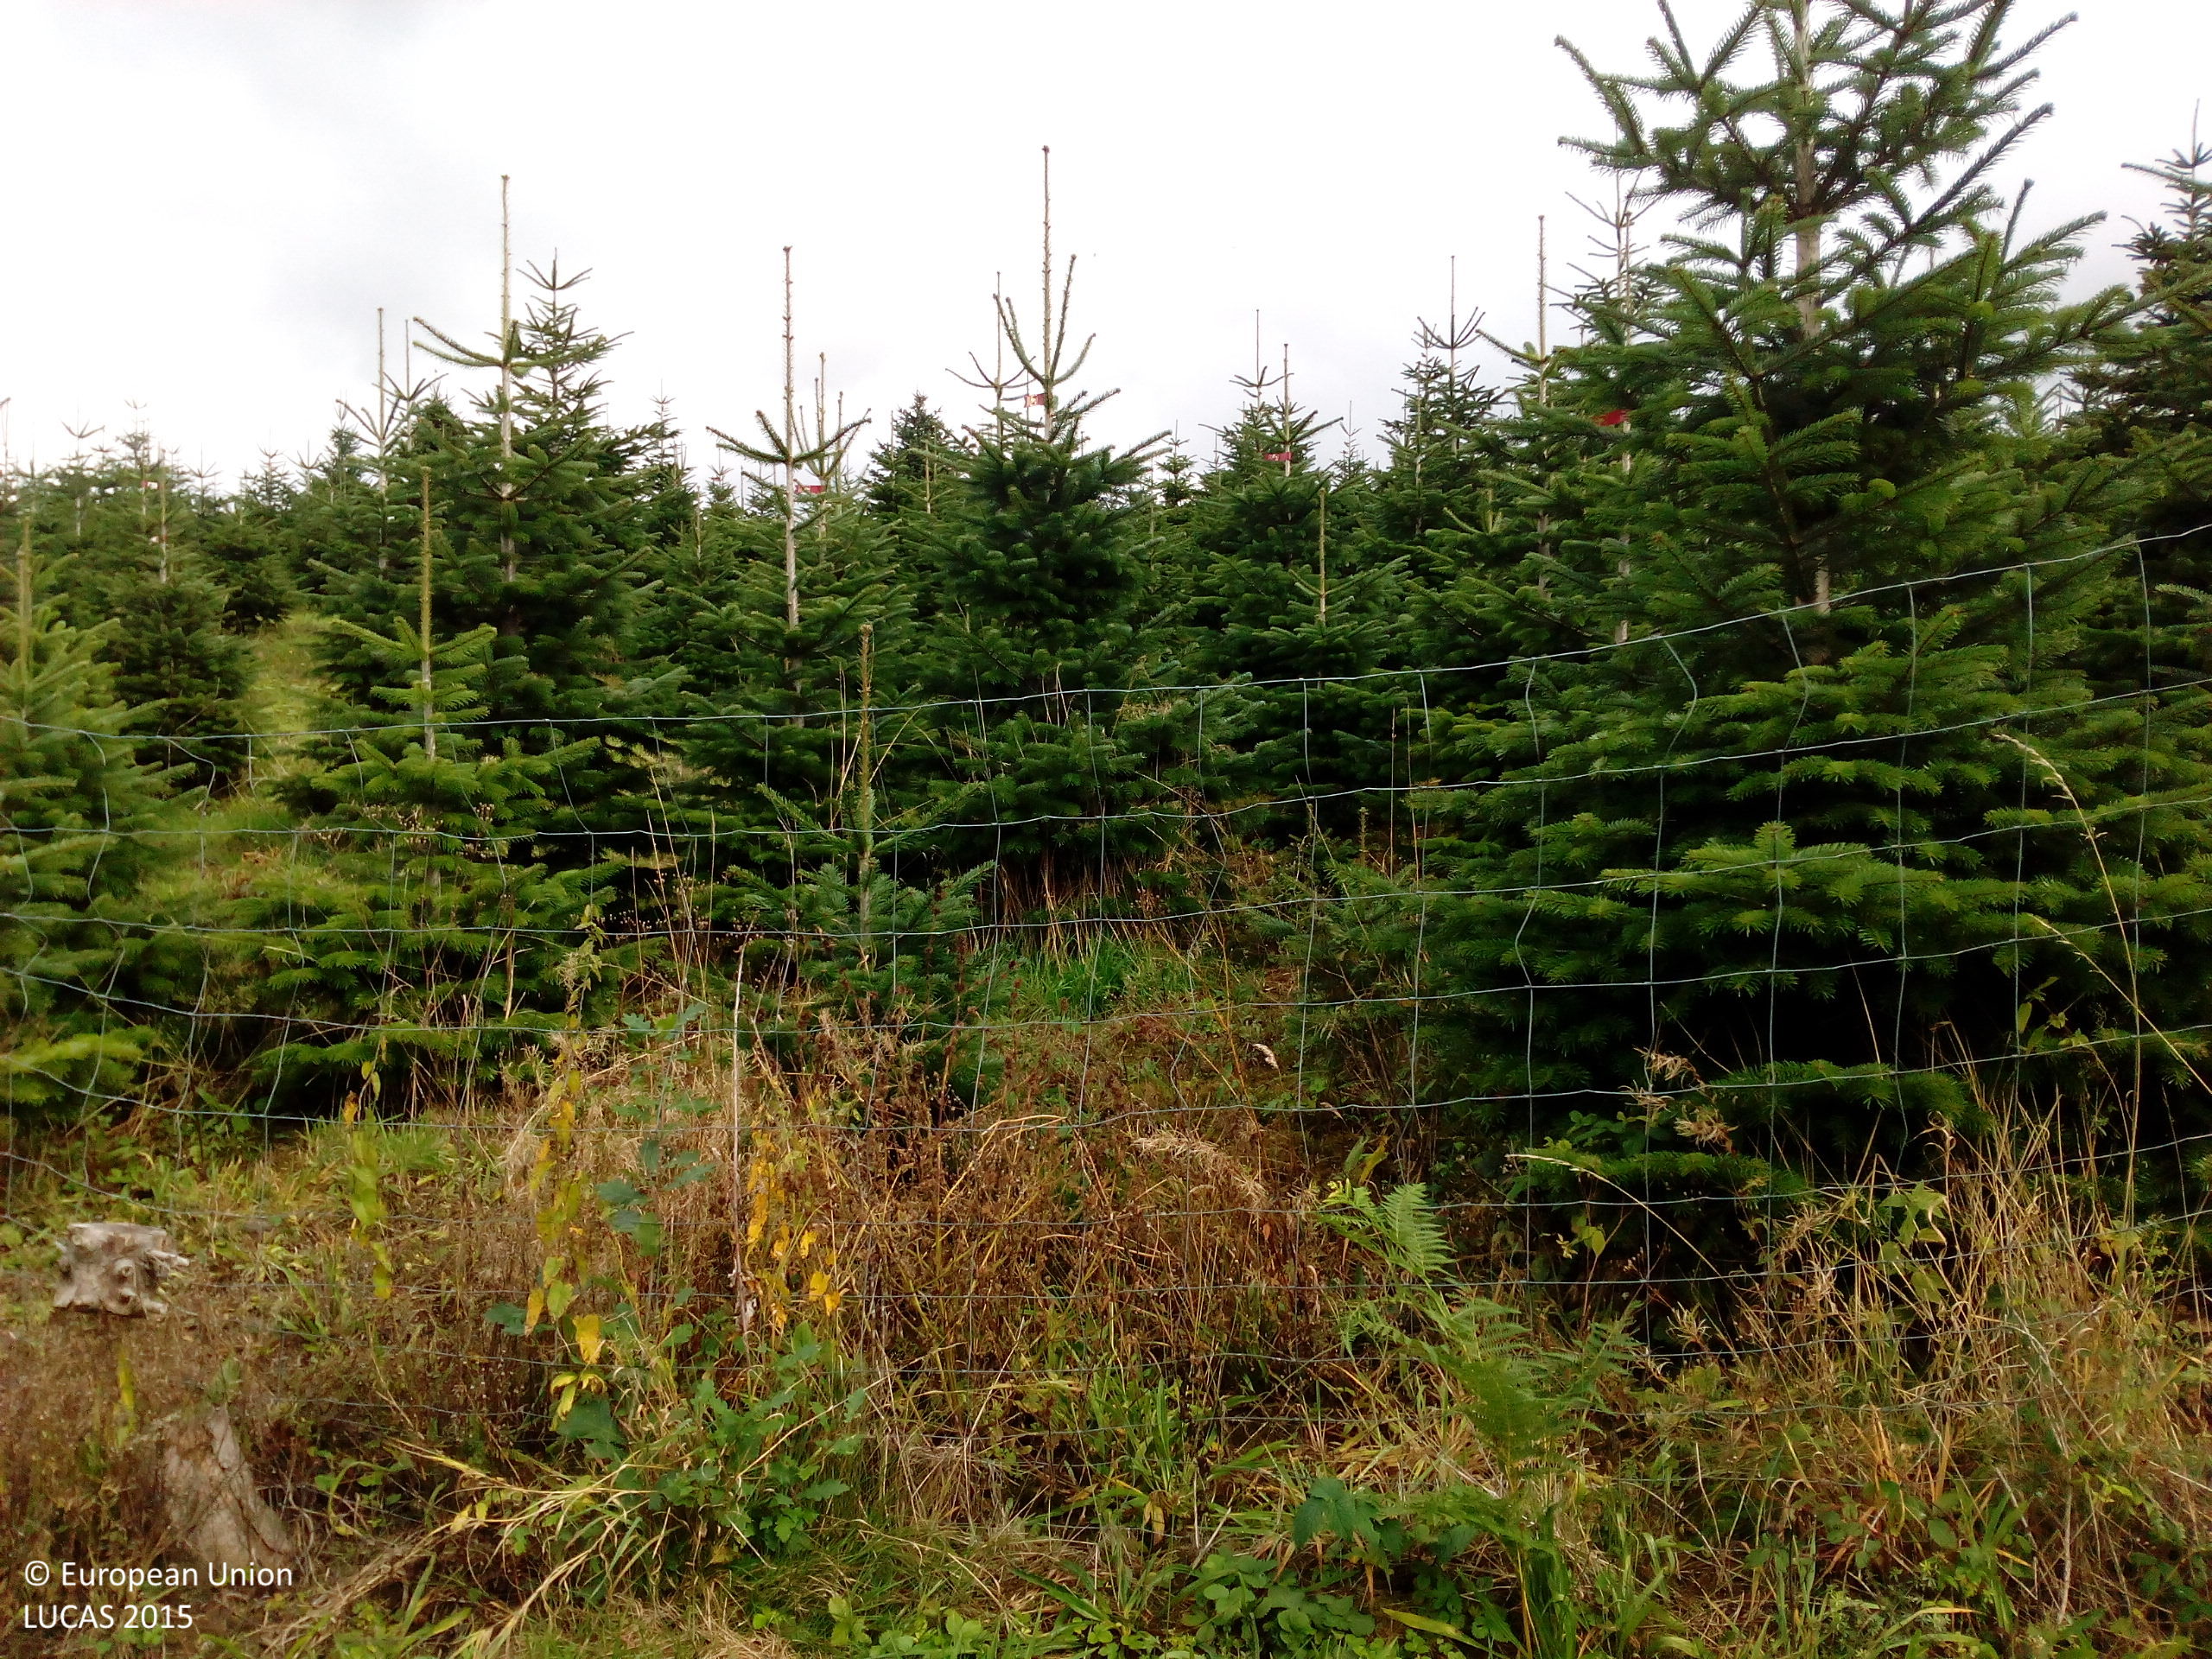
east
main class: Cropland
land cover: Other fruit trees and berries
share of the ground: 10 - 25 %
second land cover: Grassland without tree/shrub cover
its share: > 75 %
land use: Agriculture (excluding fallow land and kitchen gardens)
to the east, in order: Other fruit trees and berries; Grassland without tree/shrub cover; Fences; Nurseries; Fences; Grassland without tree/shrub cover; Tracks; Grassland without tree/shrub cover; Grassland with sparse tree/shrub cover; Electric lines; Grassland without tree/shrub cover; Fences; Nurseries
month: September
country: DE
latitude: 48.3332
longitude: 8.0989
